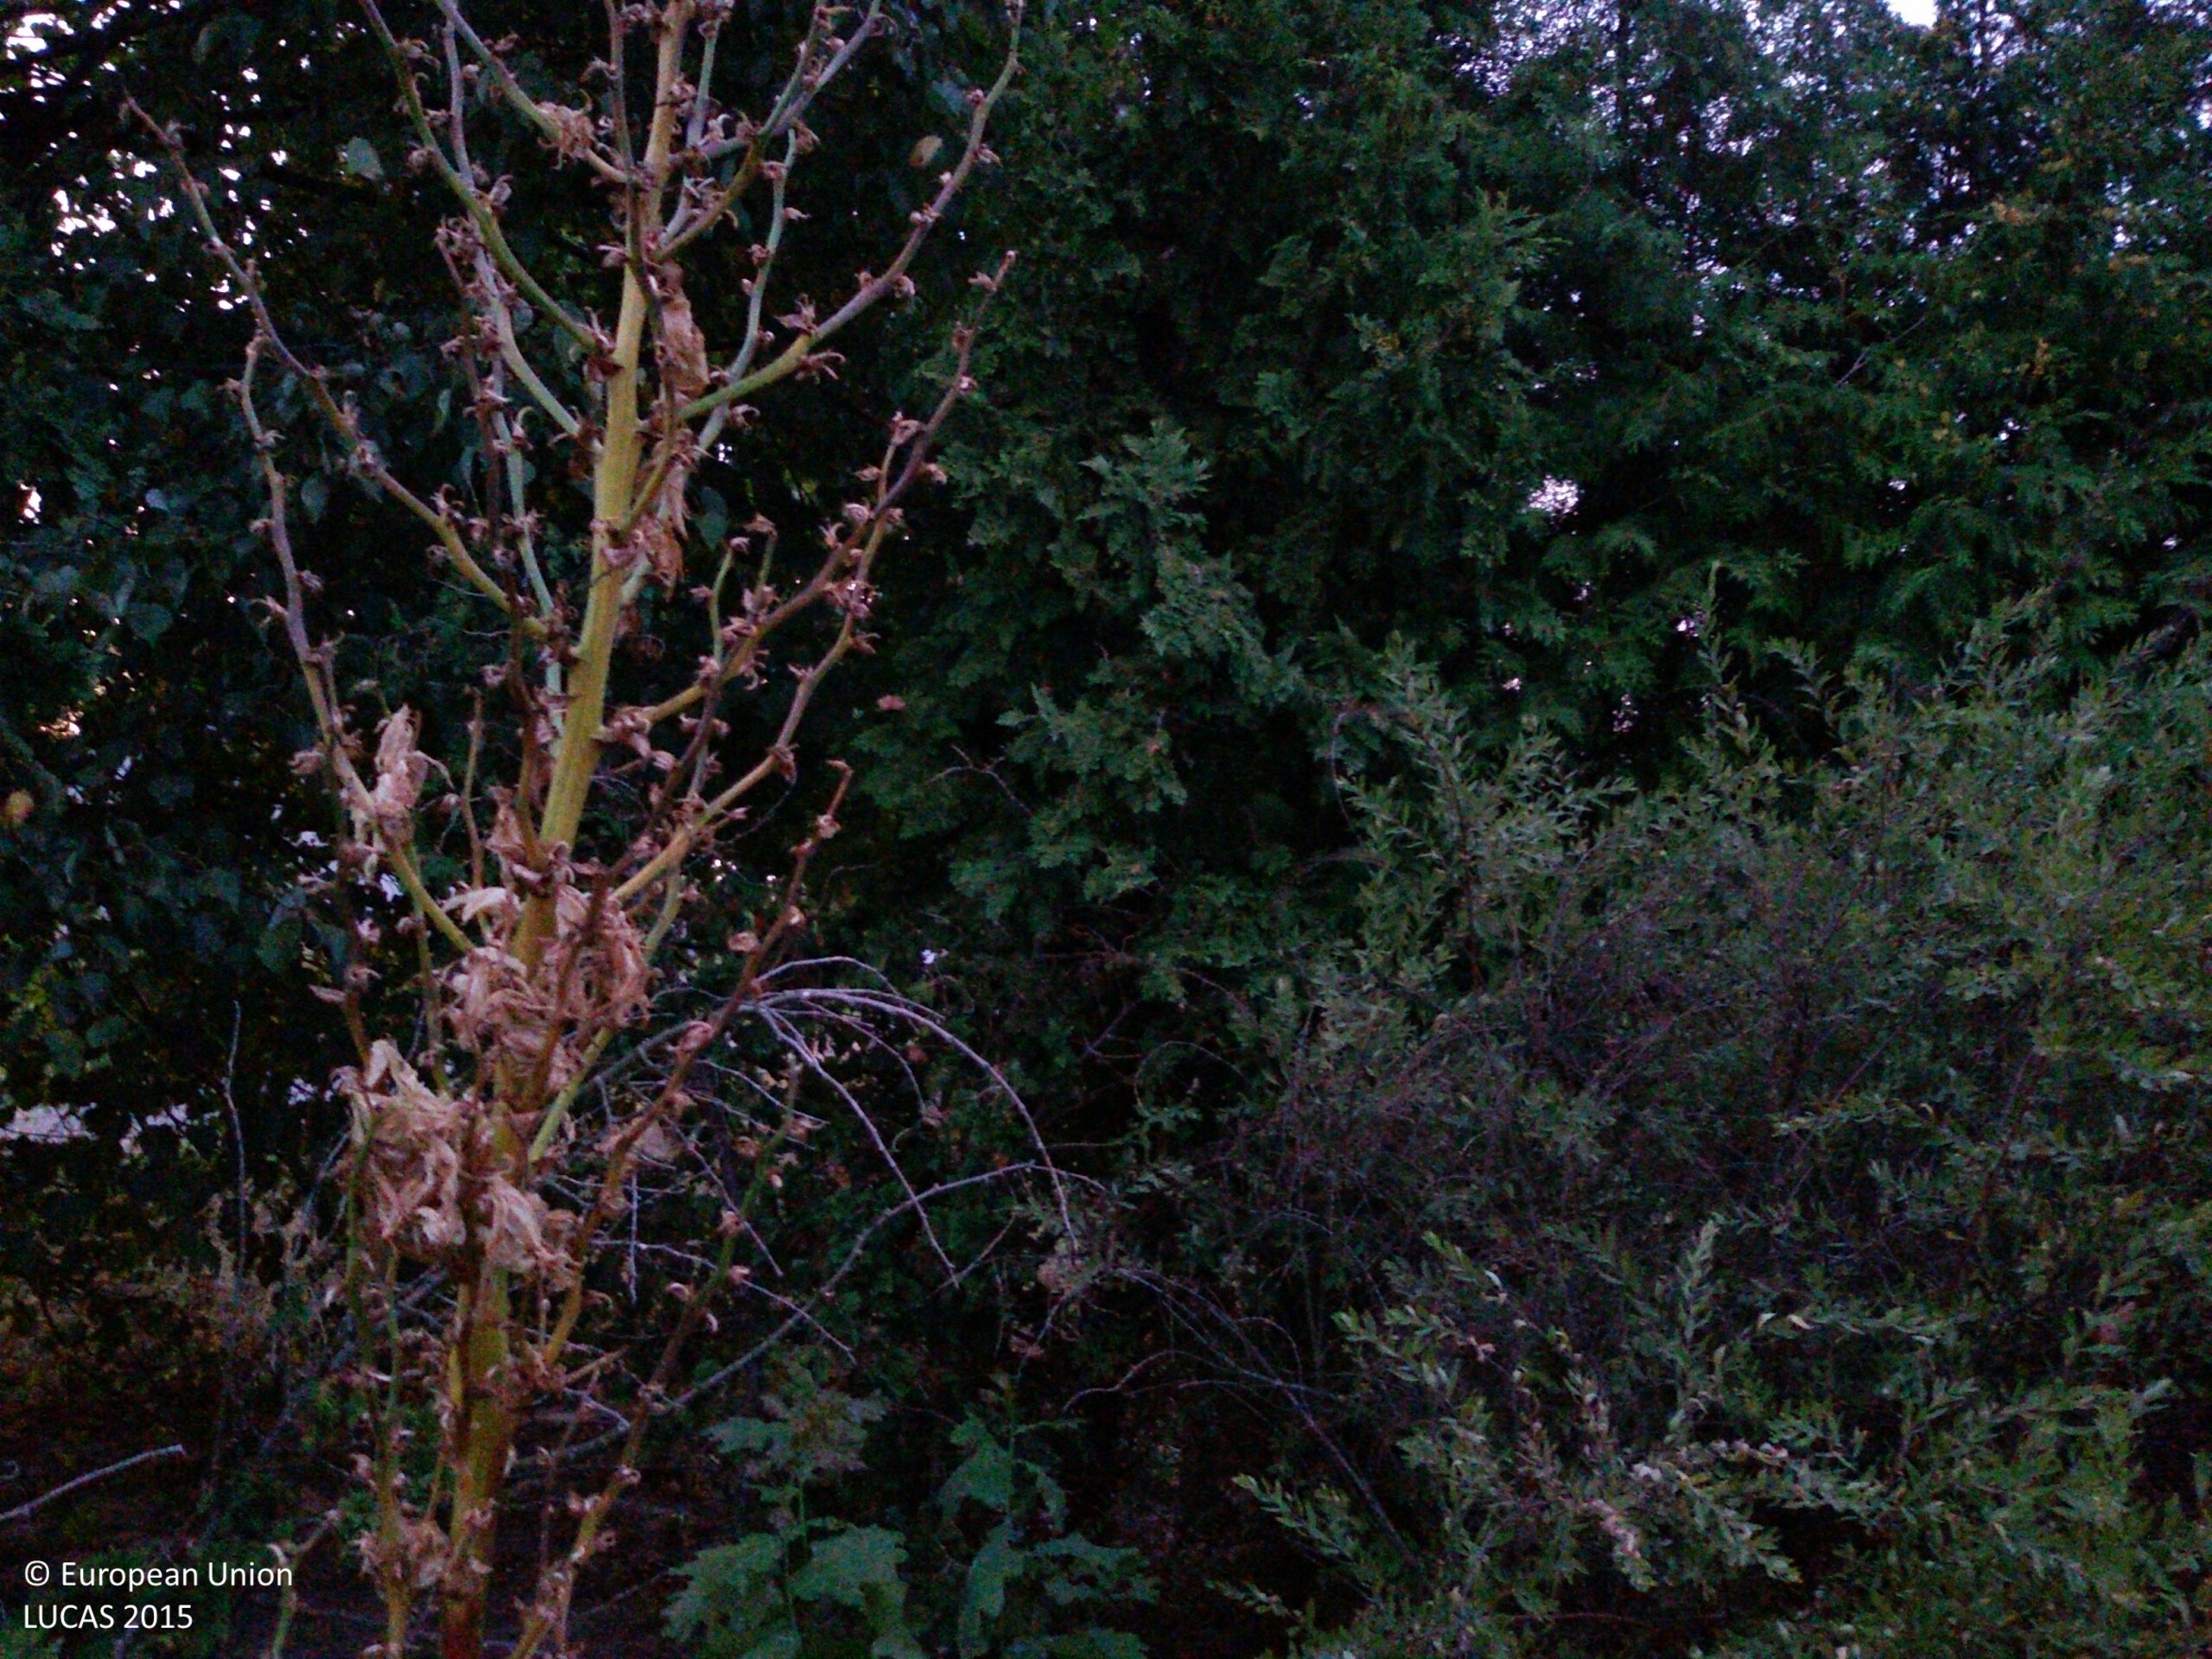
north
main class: Woodland
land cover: Broadleaved woodland
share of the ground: 10 - 25 %
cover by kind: shrubs 65 %, herbaceous plants 25 %, broadleaved forest trees 10 %
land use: Residential
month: August
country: PL
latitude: 51.4455
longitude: 22.9518
